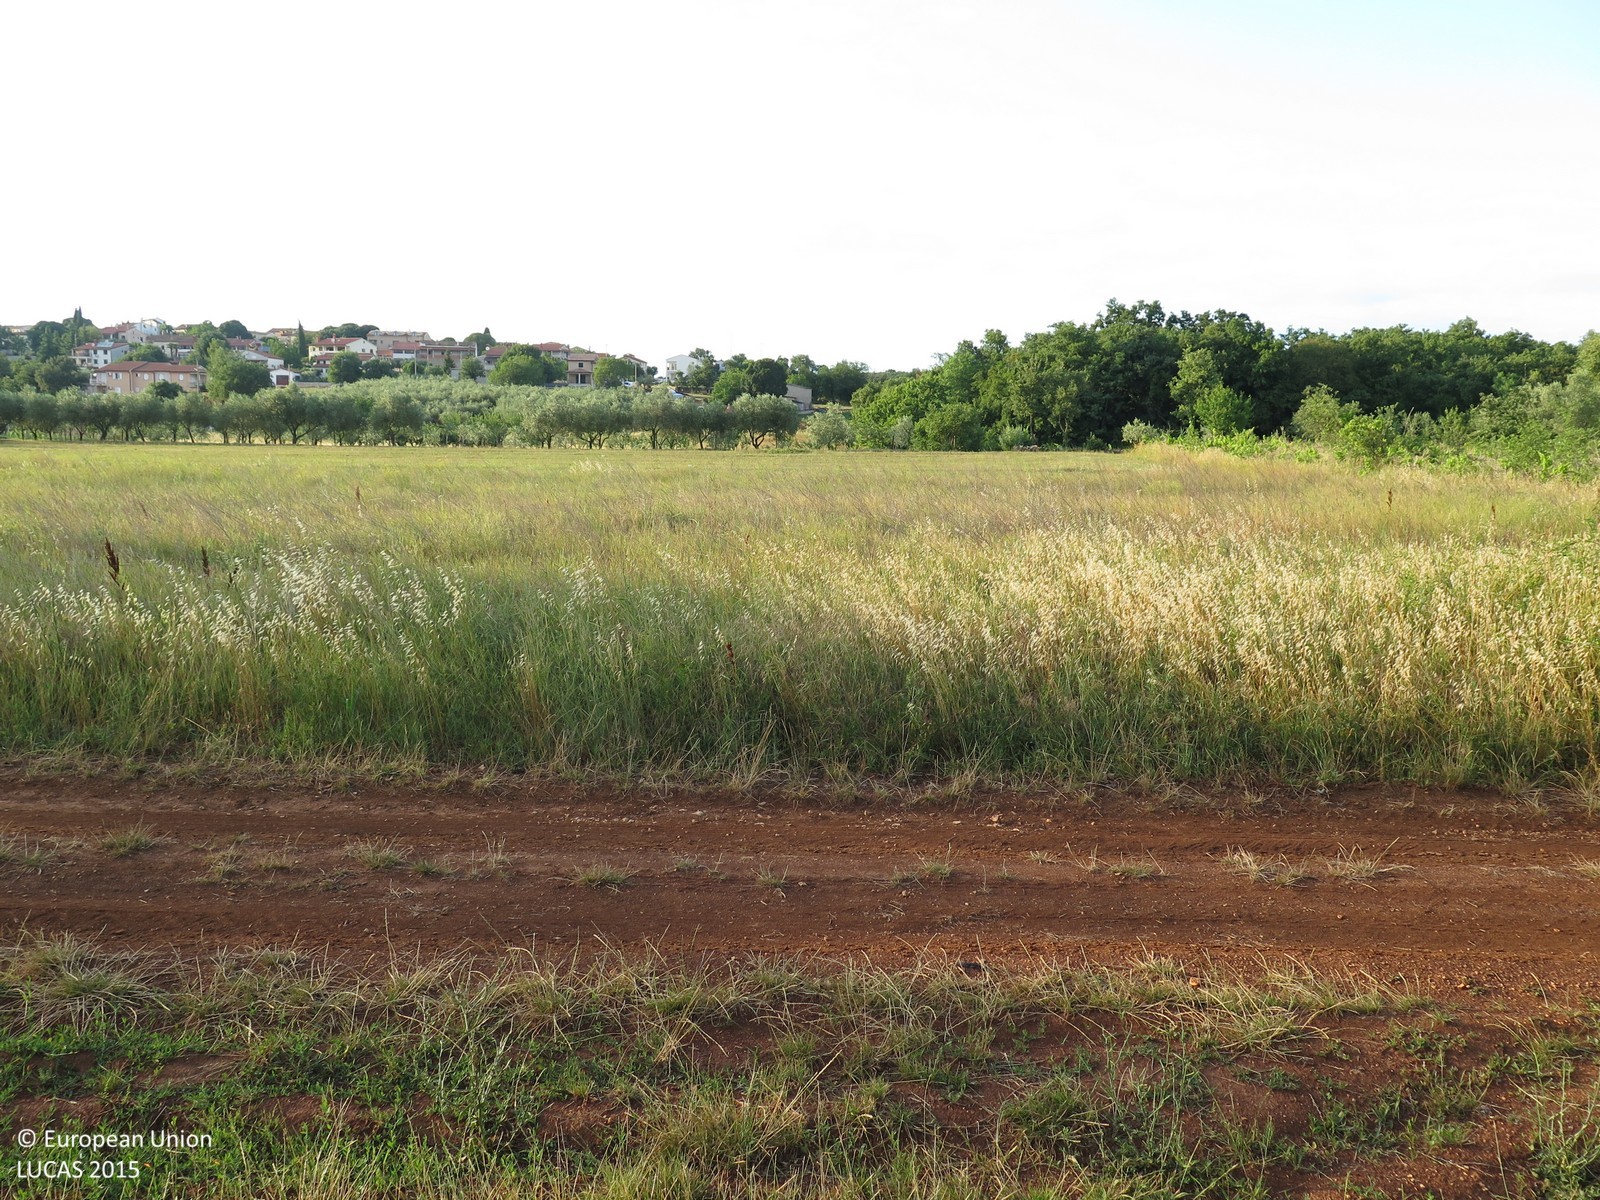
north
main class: Grassland
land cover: Grassland without tree/shrub cover
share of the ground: > 75 %
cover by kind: herbaceous plants 100 %
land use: Agriculture (excluding fallow land and kitchen gardens)
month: June
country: HR
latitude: 45.2069
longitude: 13.6488
